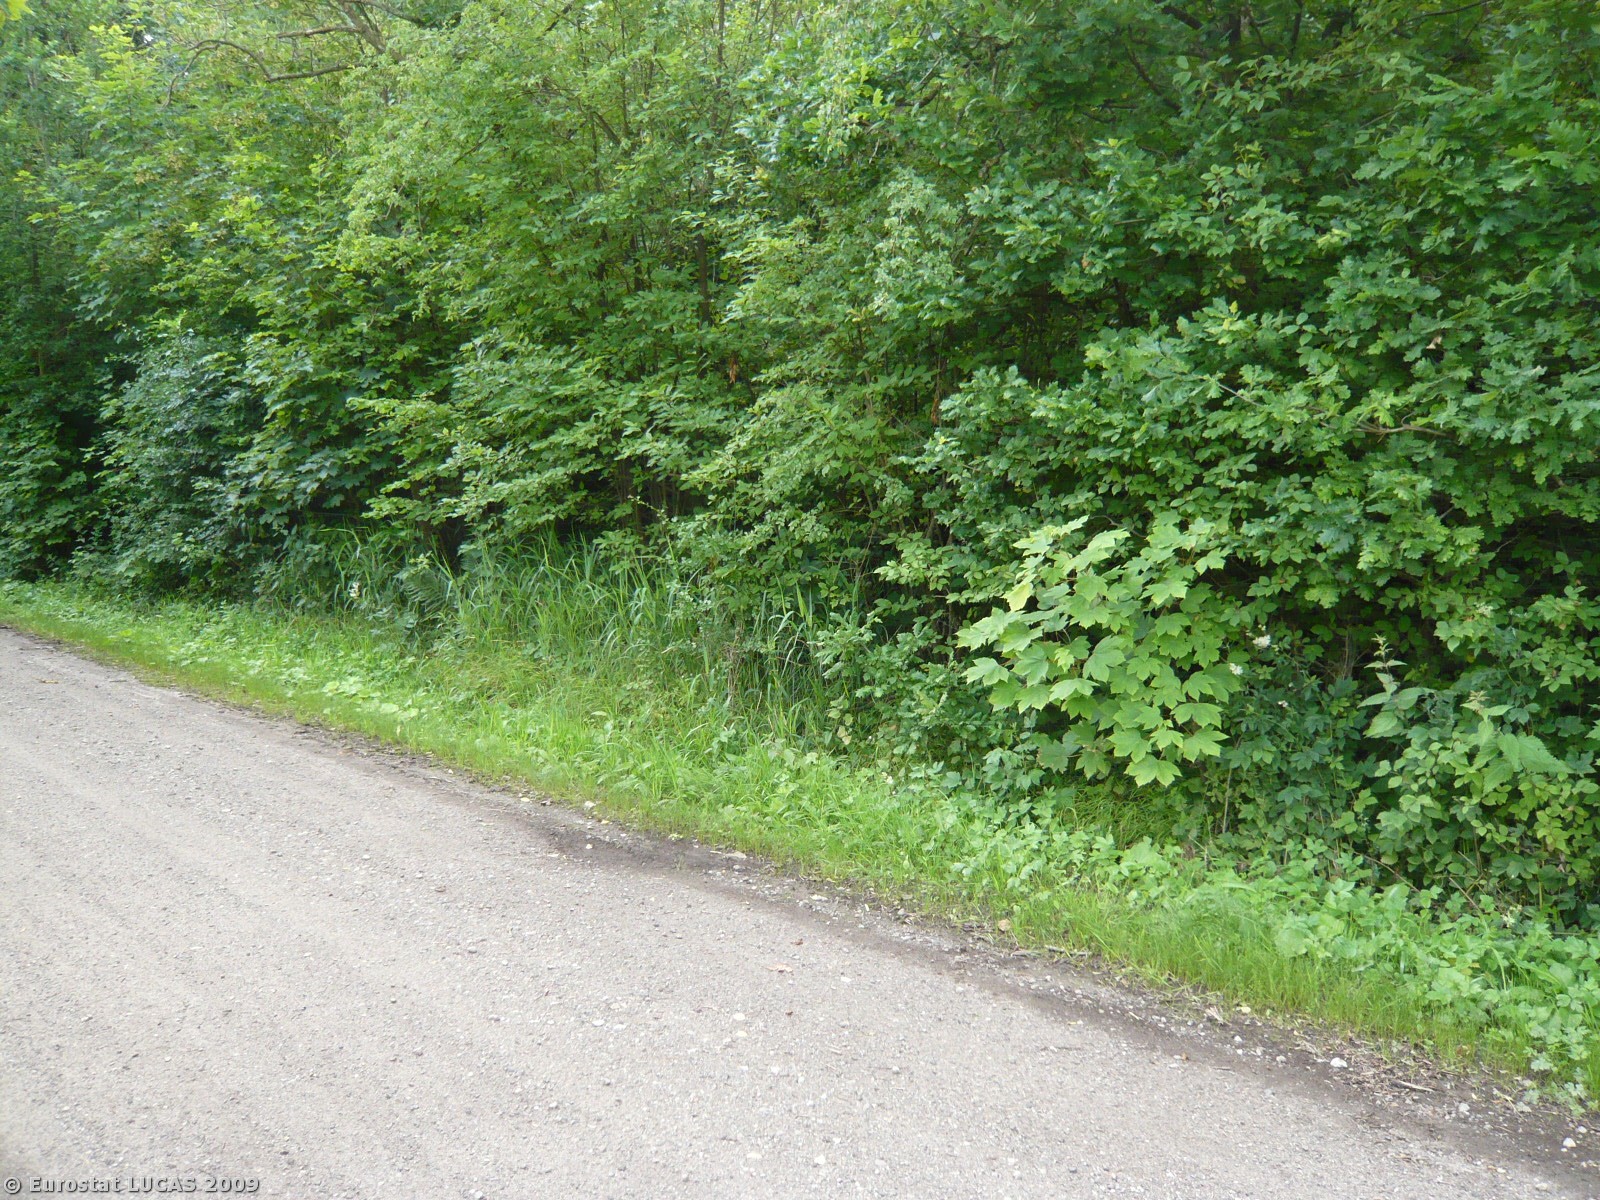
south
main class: Grassland
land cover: Grassland without tree/shrub cover
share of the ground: > 75 %
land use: Forestry
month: July
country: DK
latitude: 55.4327
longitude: 10.1737
